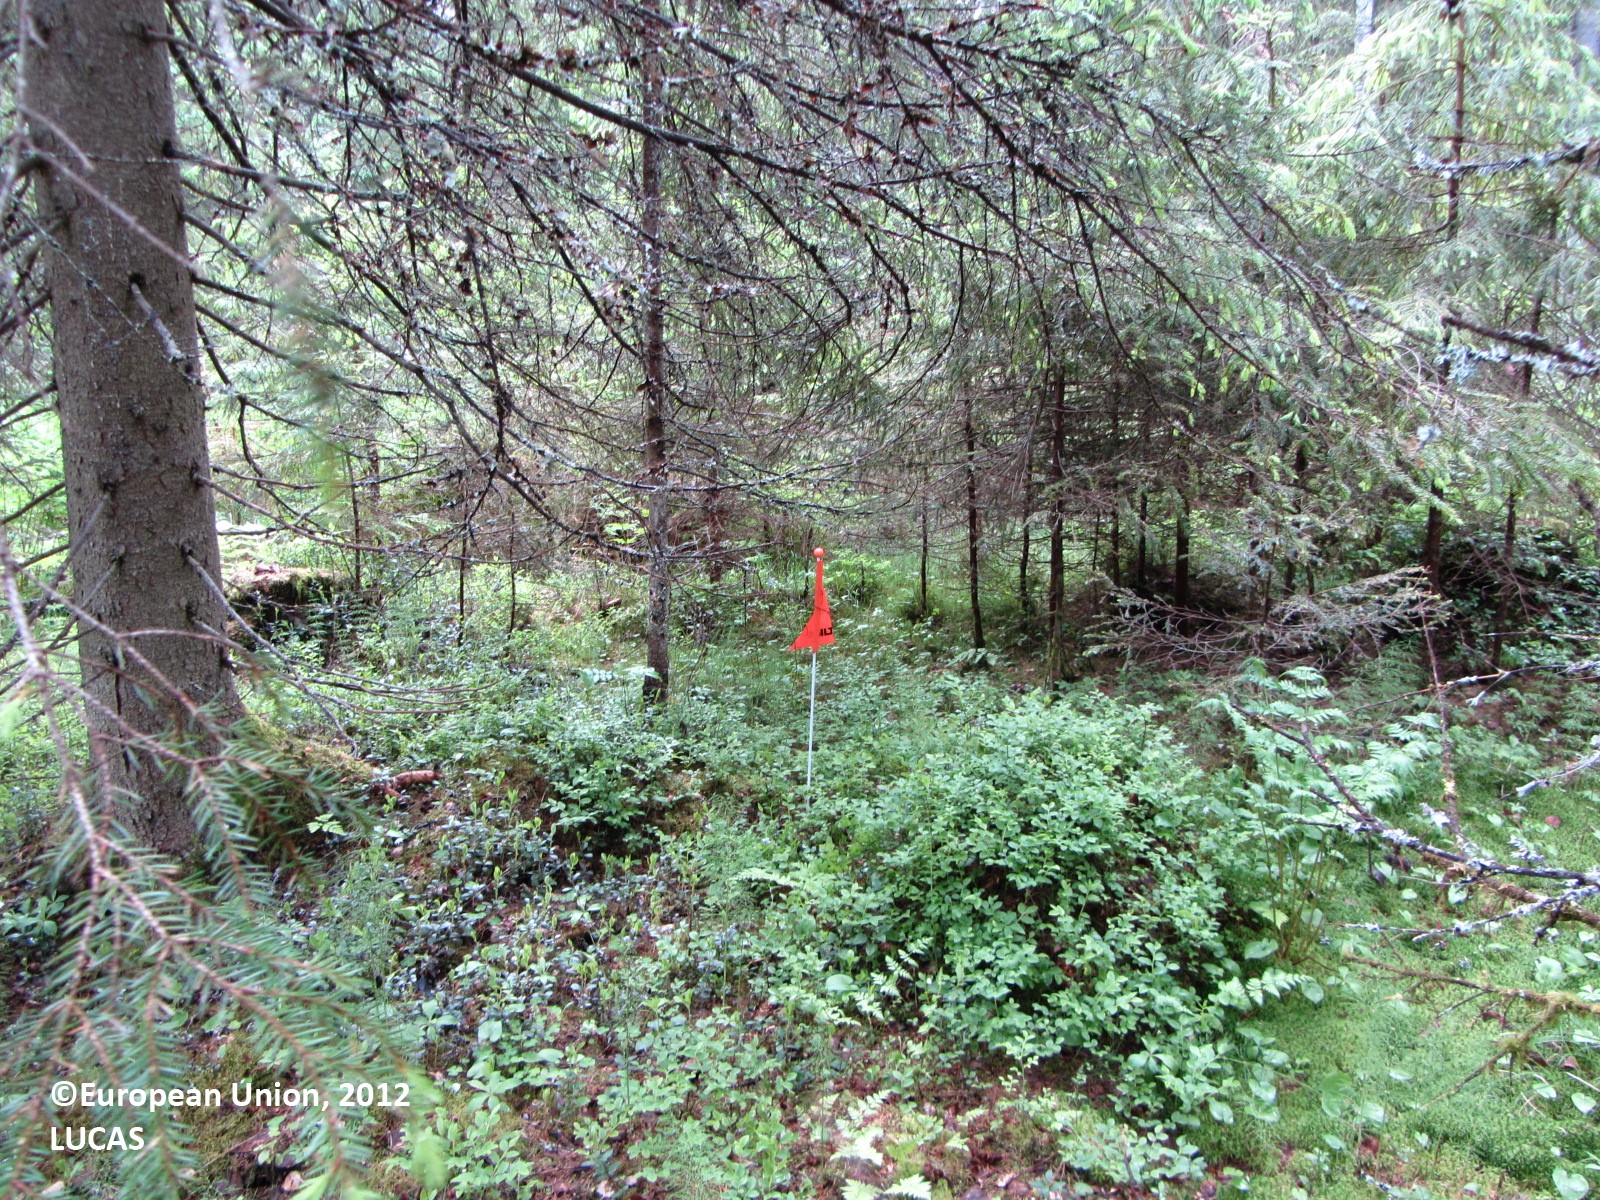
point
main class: Woodland
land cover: Spruce dominated coniferous woodland
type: boreal forest
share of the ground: > 75 %
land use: Forestry
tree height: > 5 m
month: June
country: FI
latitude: 62.4345
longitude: 25.2739
